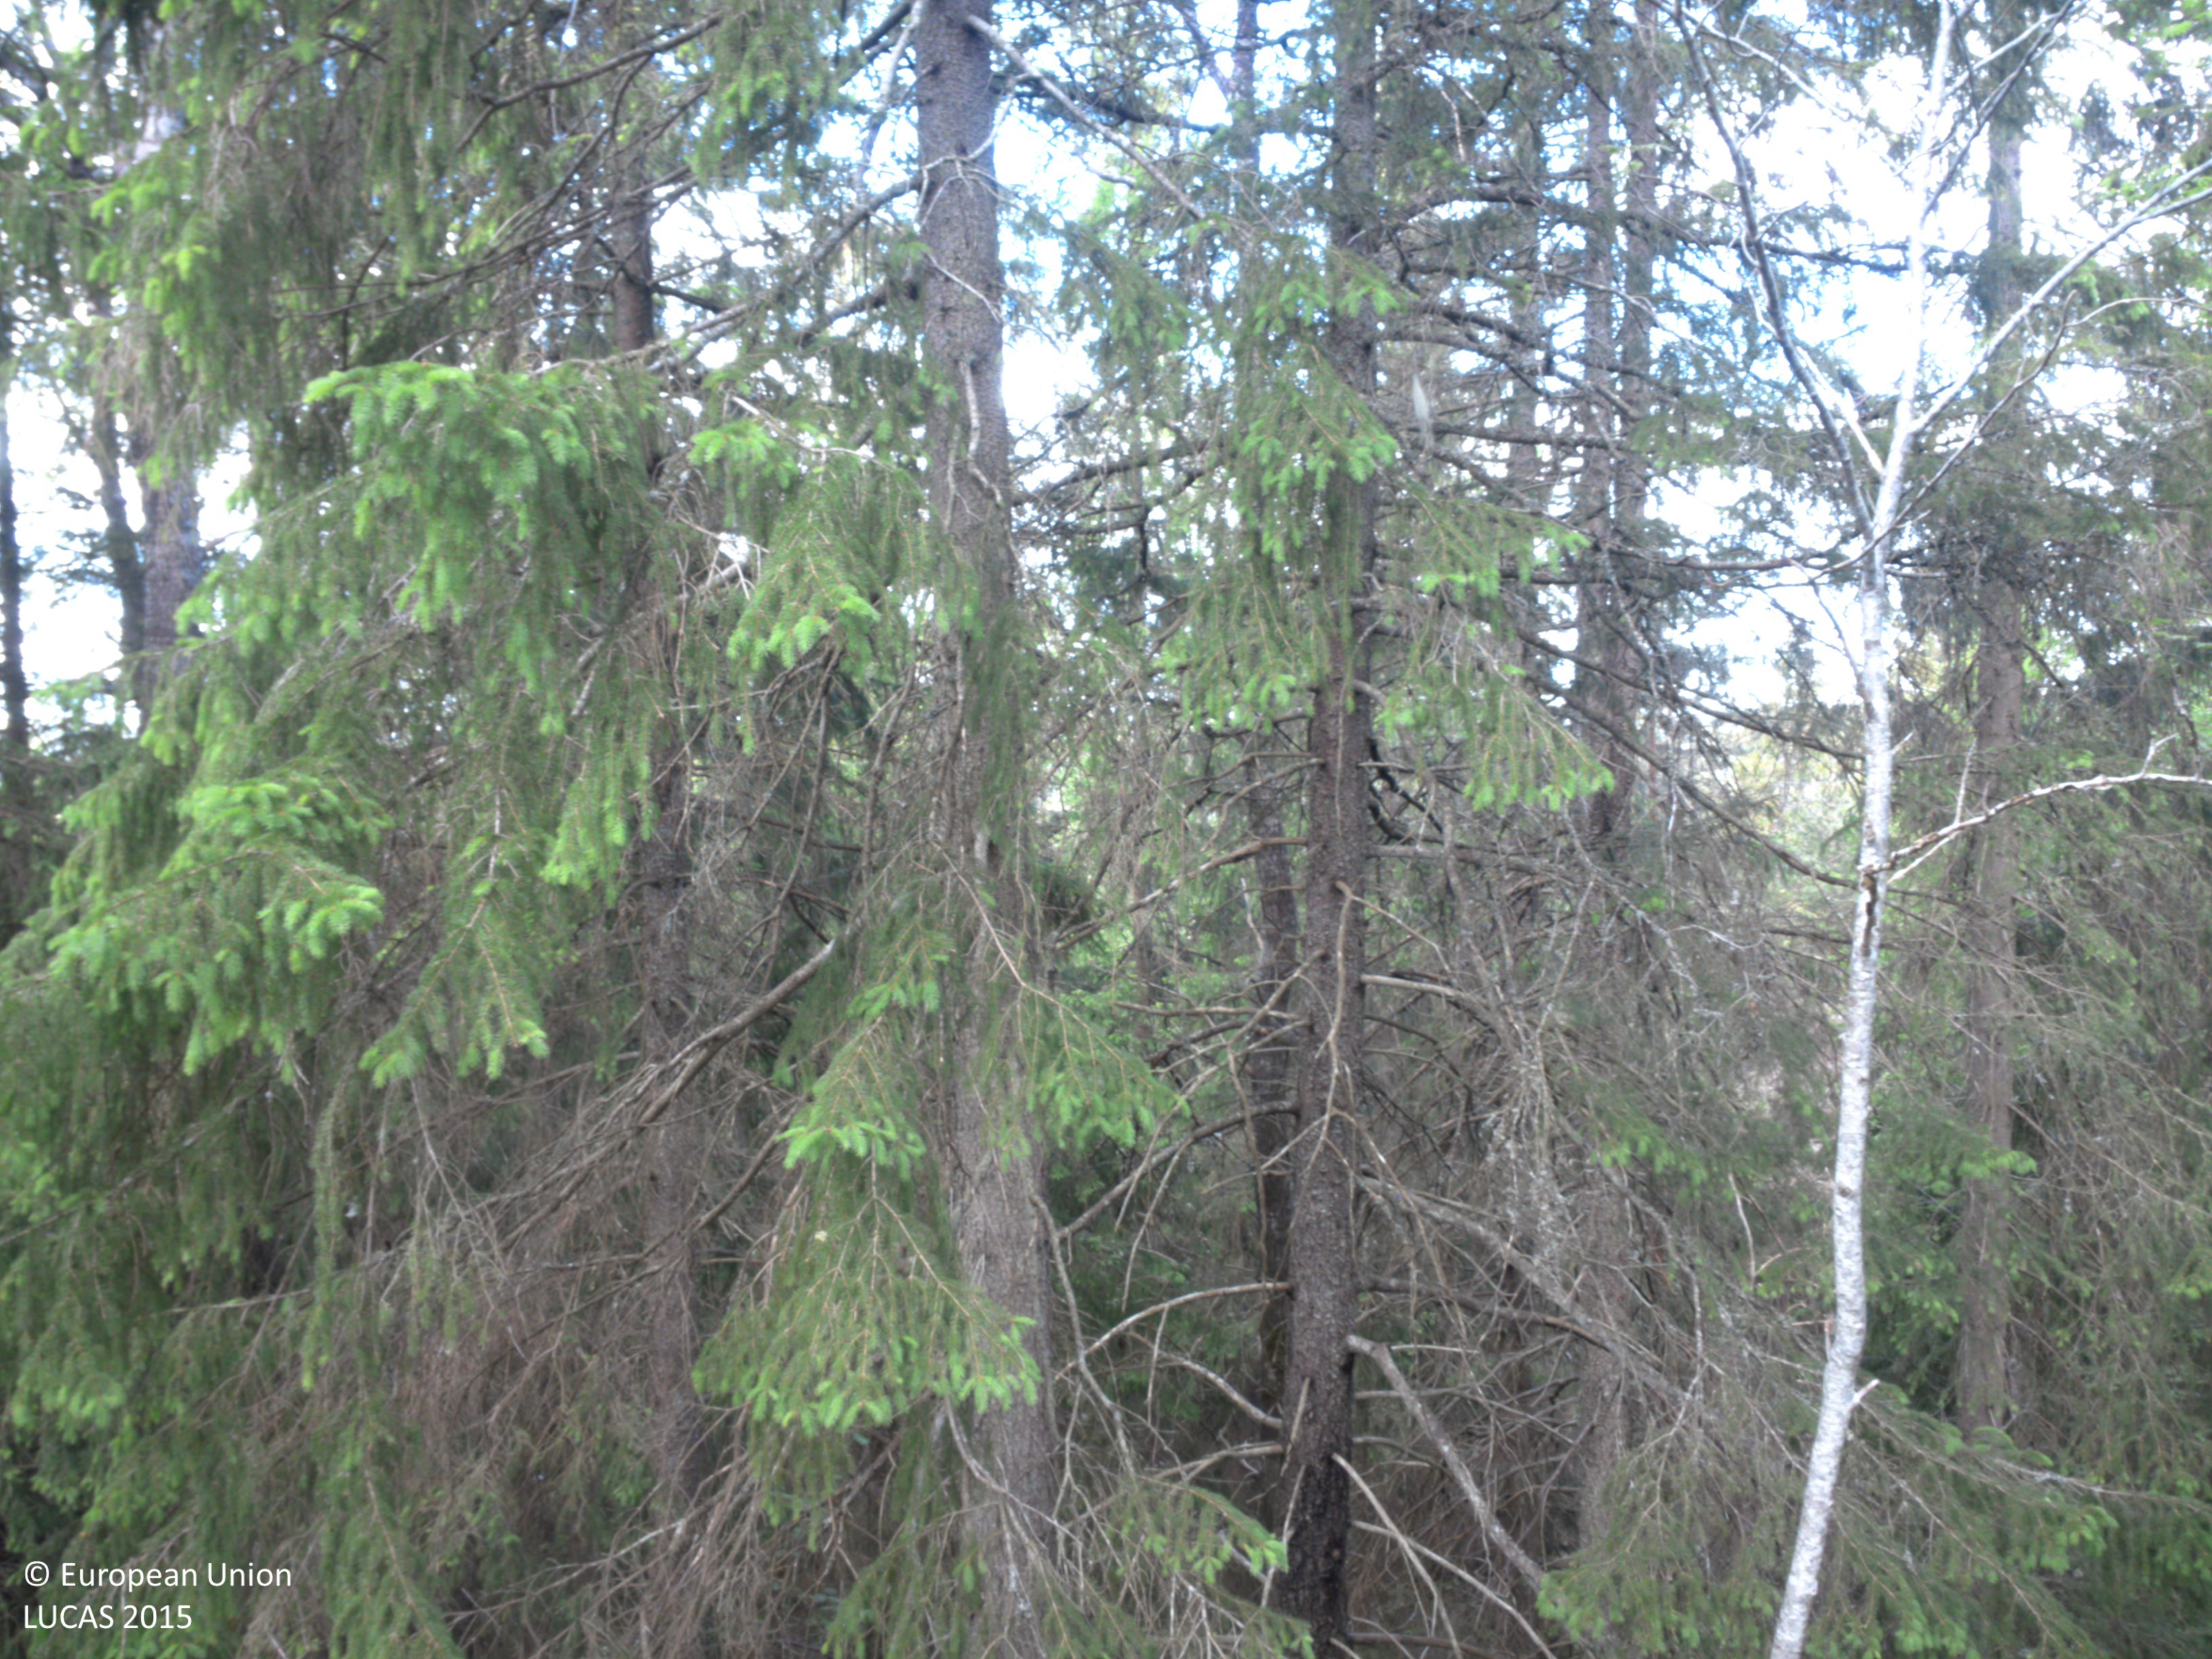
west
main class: Woodland
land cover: Other mixed woodland
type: boreal forest
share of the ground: 50 - 75 %
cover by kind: coniferous forest trees 30 %, broadleaved forest trees 25 %, herbaceous plants 15 %, lichens and mosses 15 %, consolidated bare surface 10 %, shrubs 5 %
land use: Forestry
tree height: > 5 m
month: June
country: SE
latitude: 58.9921
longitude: 12.2746
